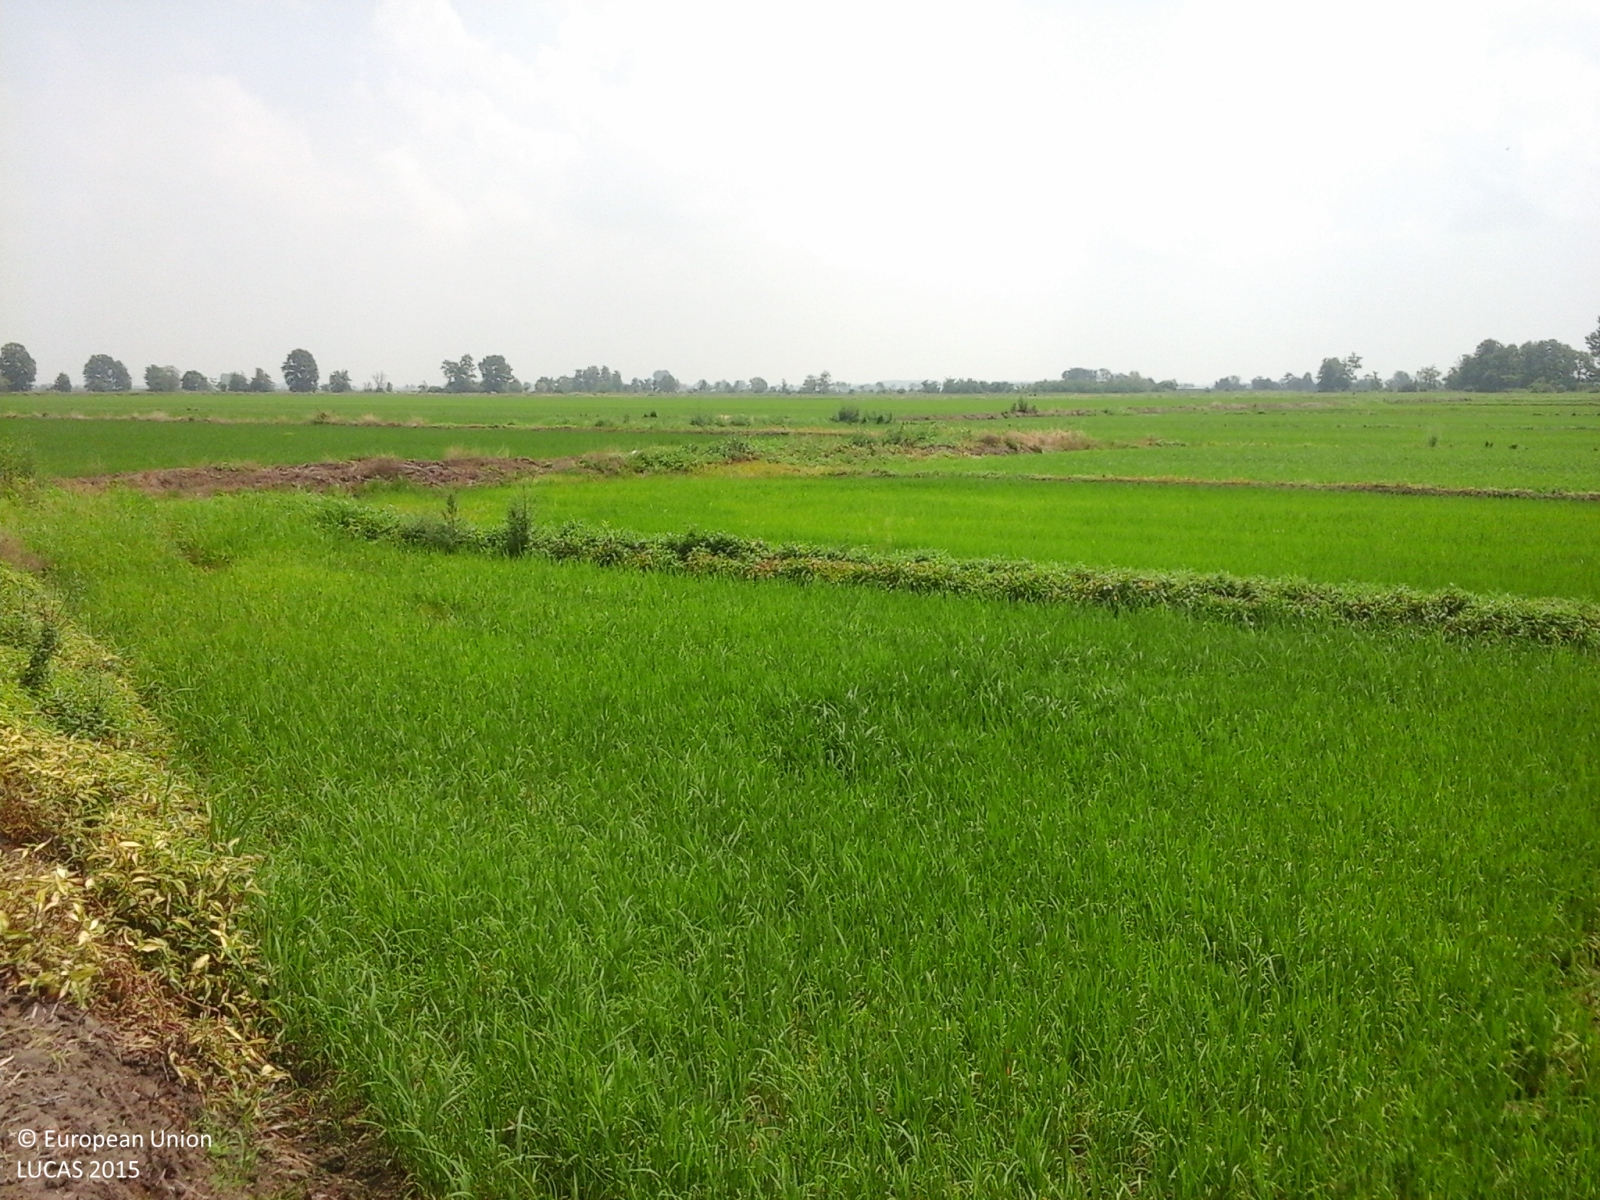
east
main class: Cropland
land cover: Rice
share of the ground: > 75 %
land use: Agriculture (excluding fallow land and kitchen gardens)
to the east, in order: Rice; Other structural elements; Rice; Other structural elements; Rice; Other structural elements; Rice; Grassland without tree/shrub cover; Rice; Other structural elements; Rice
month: June
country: IT
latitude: 45.2426
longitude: 8.5884
